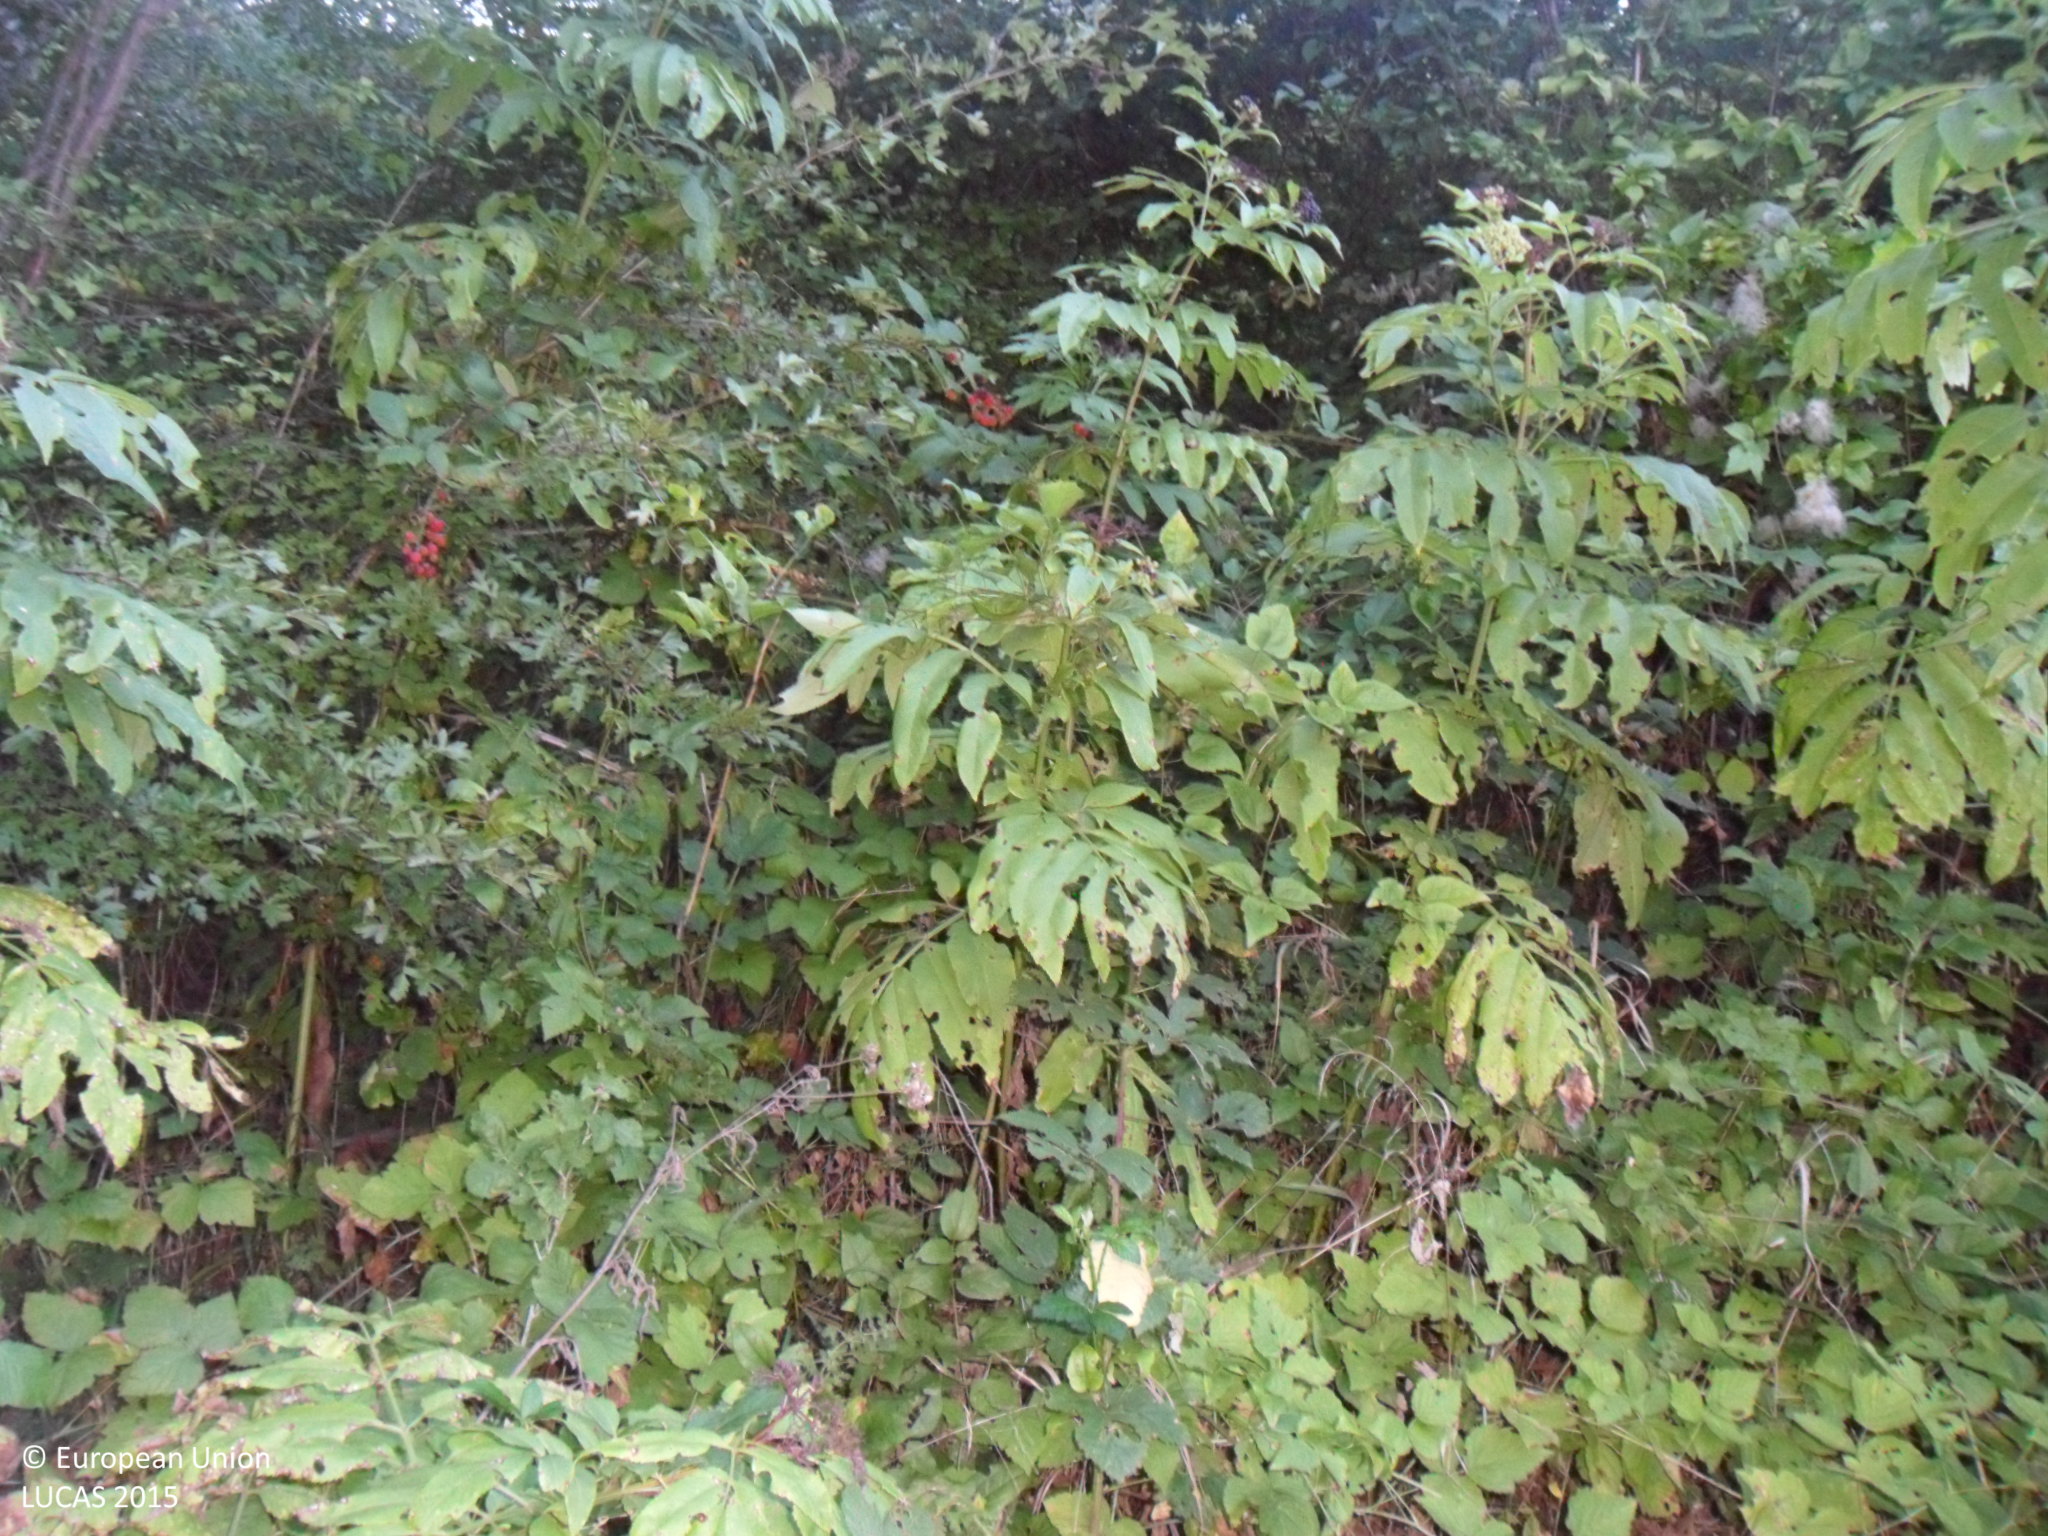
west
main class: Woodland
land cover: Broadleaved woodland
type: mesophytic deciduous forest
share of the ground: 50 - 75 %
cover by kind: broadleaved forest trees 60 %, shrubs 30 %, herbaceous plants 10 %
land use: Forestry
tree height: > 5 m
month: September
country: BG
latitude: 43.1616
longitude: 26.7473
